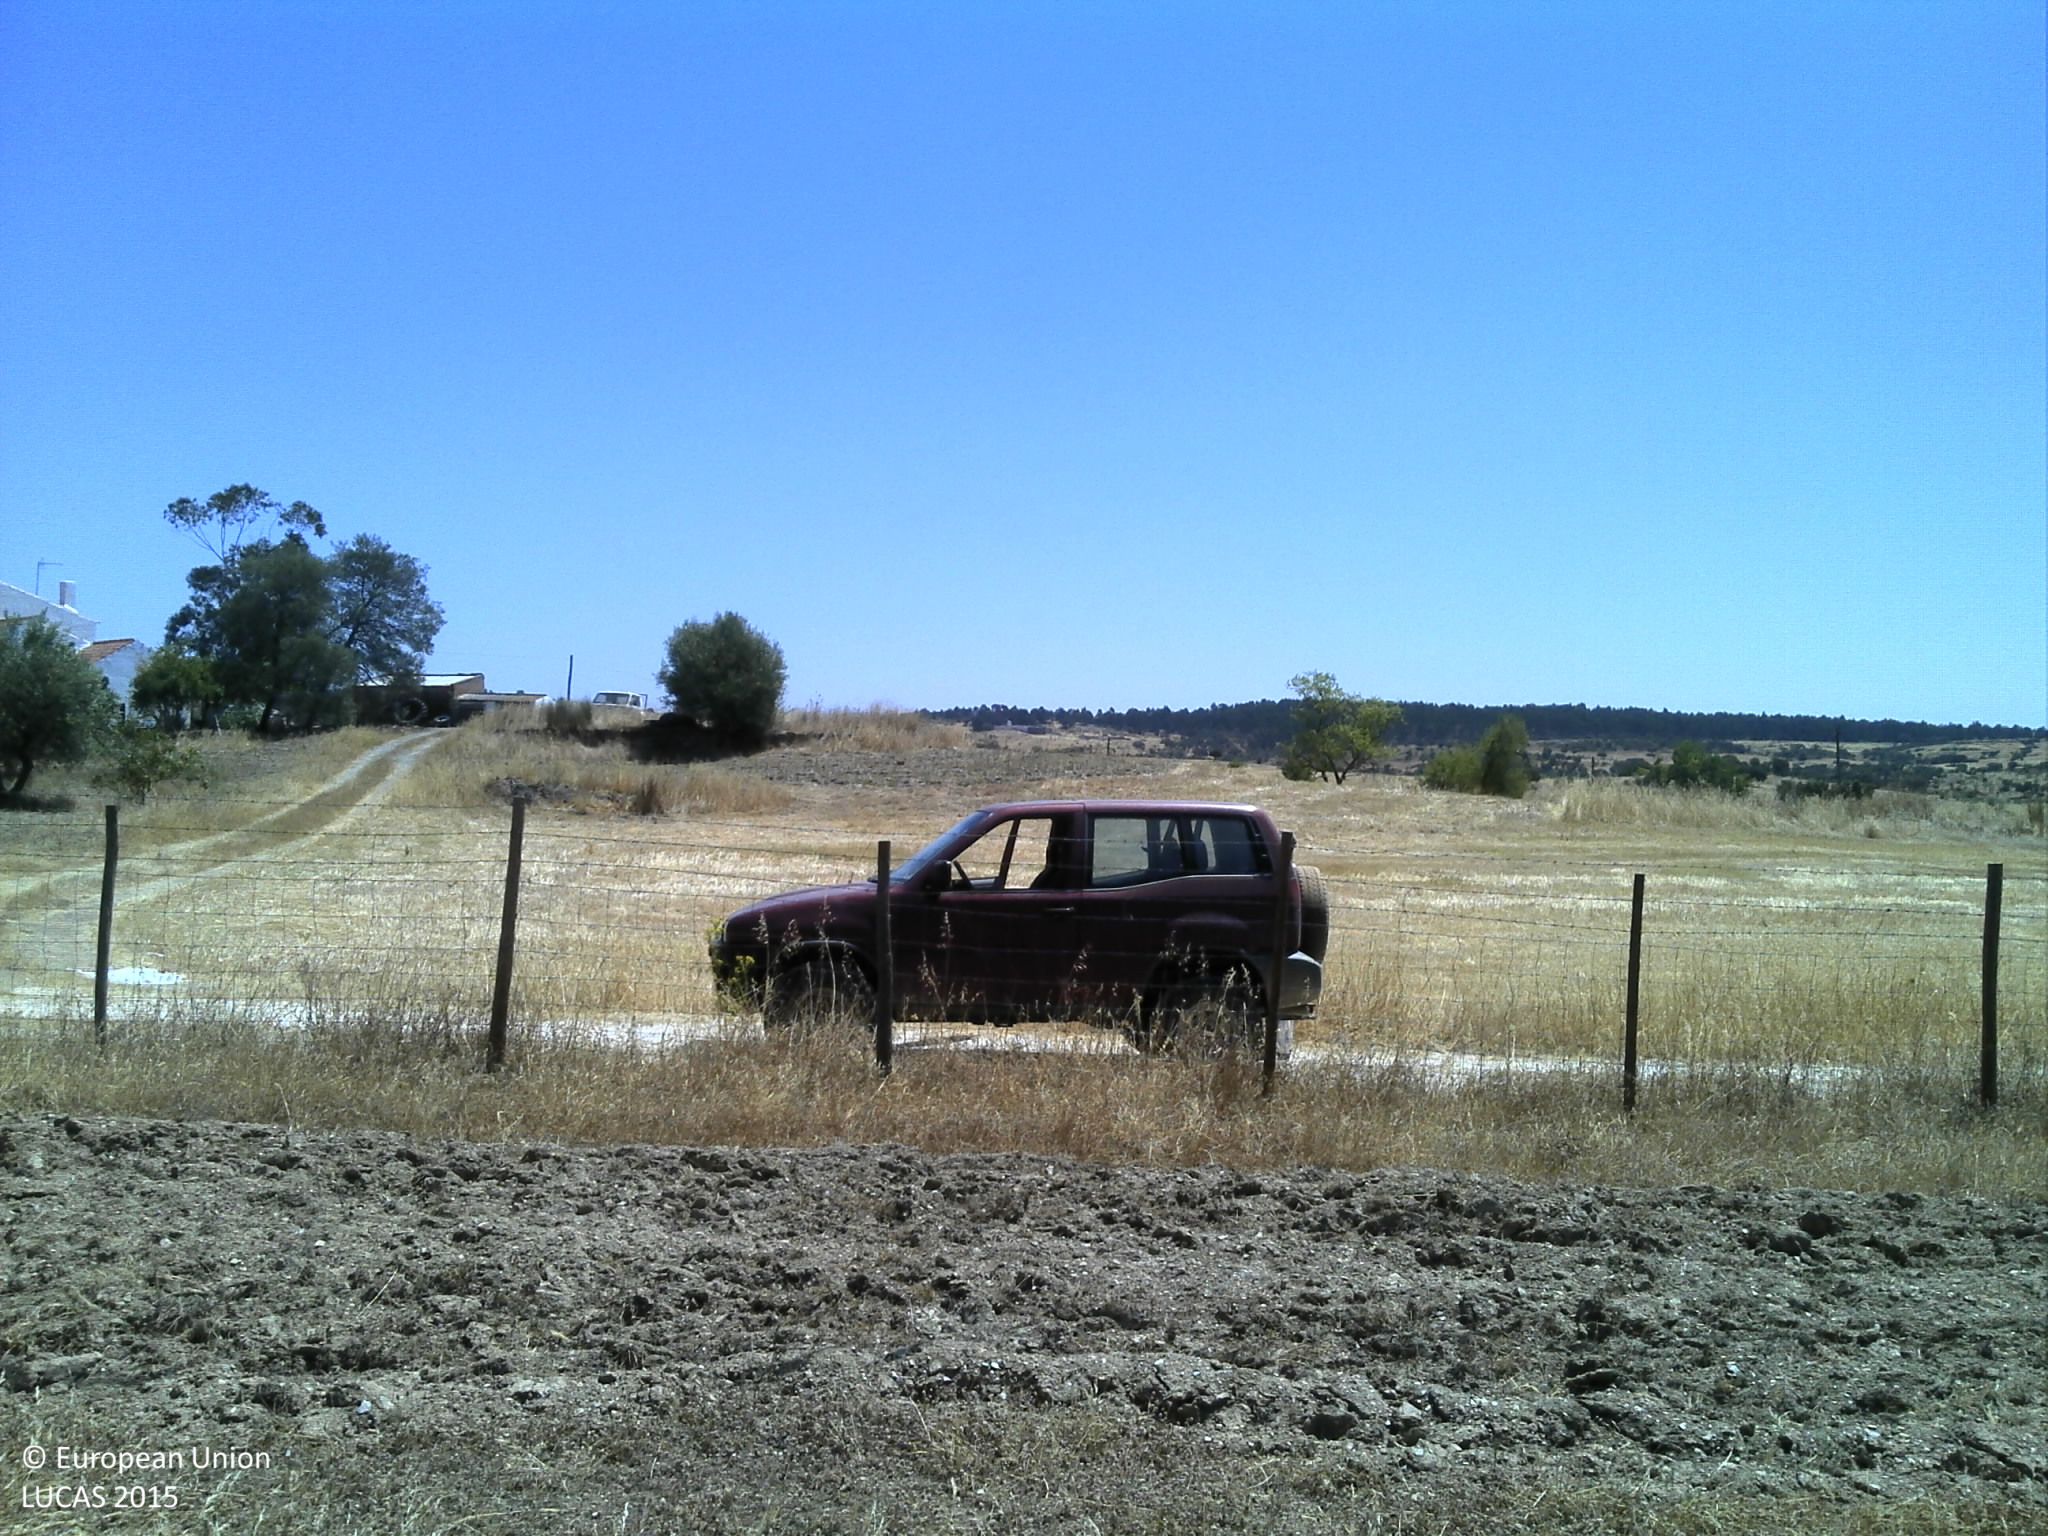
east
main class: Grassland
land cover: Grassland without tree/shrub cover
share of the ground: 10 - 25 %
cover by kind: unconsolidated bare surface 90 %, herbaceous plants 10 %
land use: Agriculture (excluding fallow land and kitchen gardens)
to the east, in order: Grassland without tree/shrub cover; Other bare soil; Electric lines; Grass margins; Fences; Grass margins; Tracks; Grass margins; Spontaneously vegetated surfaces; Tracks; Spontaneously vegetated surfaces; Nuts trees; Spontaneously vegetated surfaces; Electric lines; Spontaneously vegetated surfaces; Ditches and canals; Tracks; Grass margins; Other bare soil; Grassland without tree/shrub cover; Electric lines; Grassland without tree/shrub cover
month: July
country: PT
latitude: 38.6496
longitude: -7.3670
